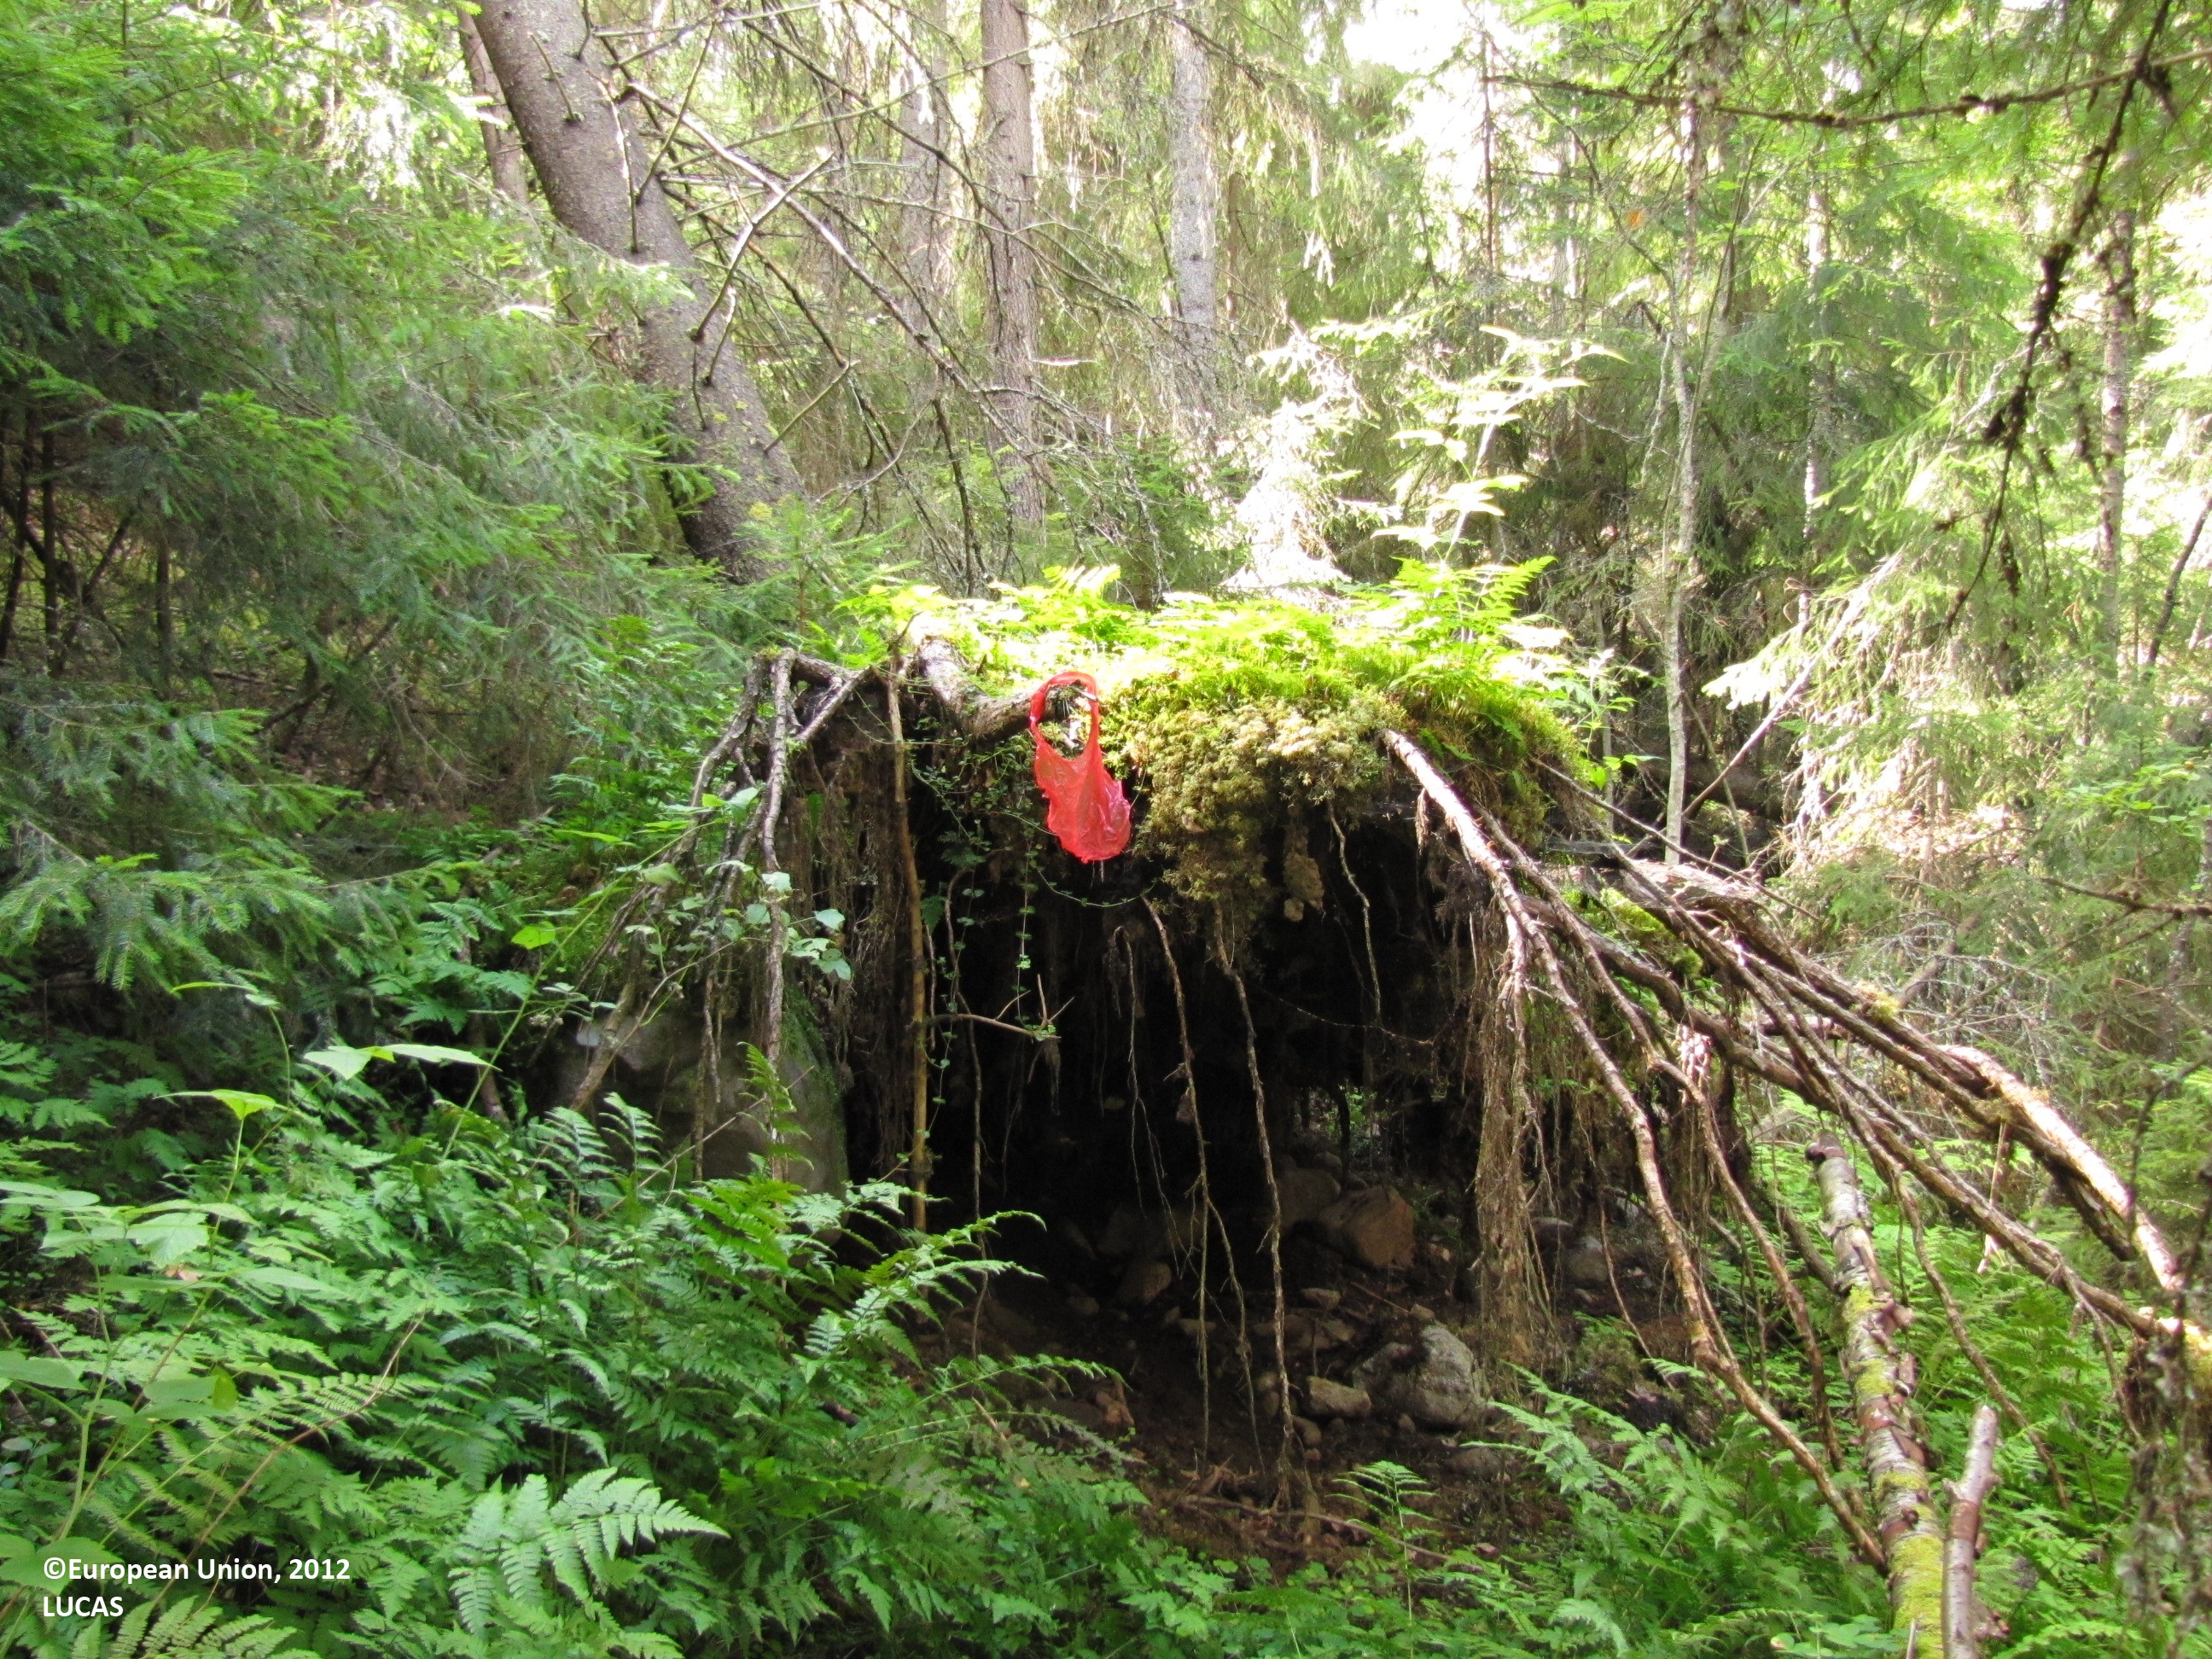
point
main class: Woodland
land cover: Spruce dominated coniferous woodland
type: boreal forest
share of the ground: 50 - 75 %
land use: Forestry
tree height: > 5 m
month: August
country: FI
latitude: 61.7390
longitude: 23.1537
